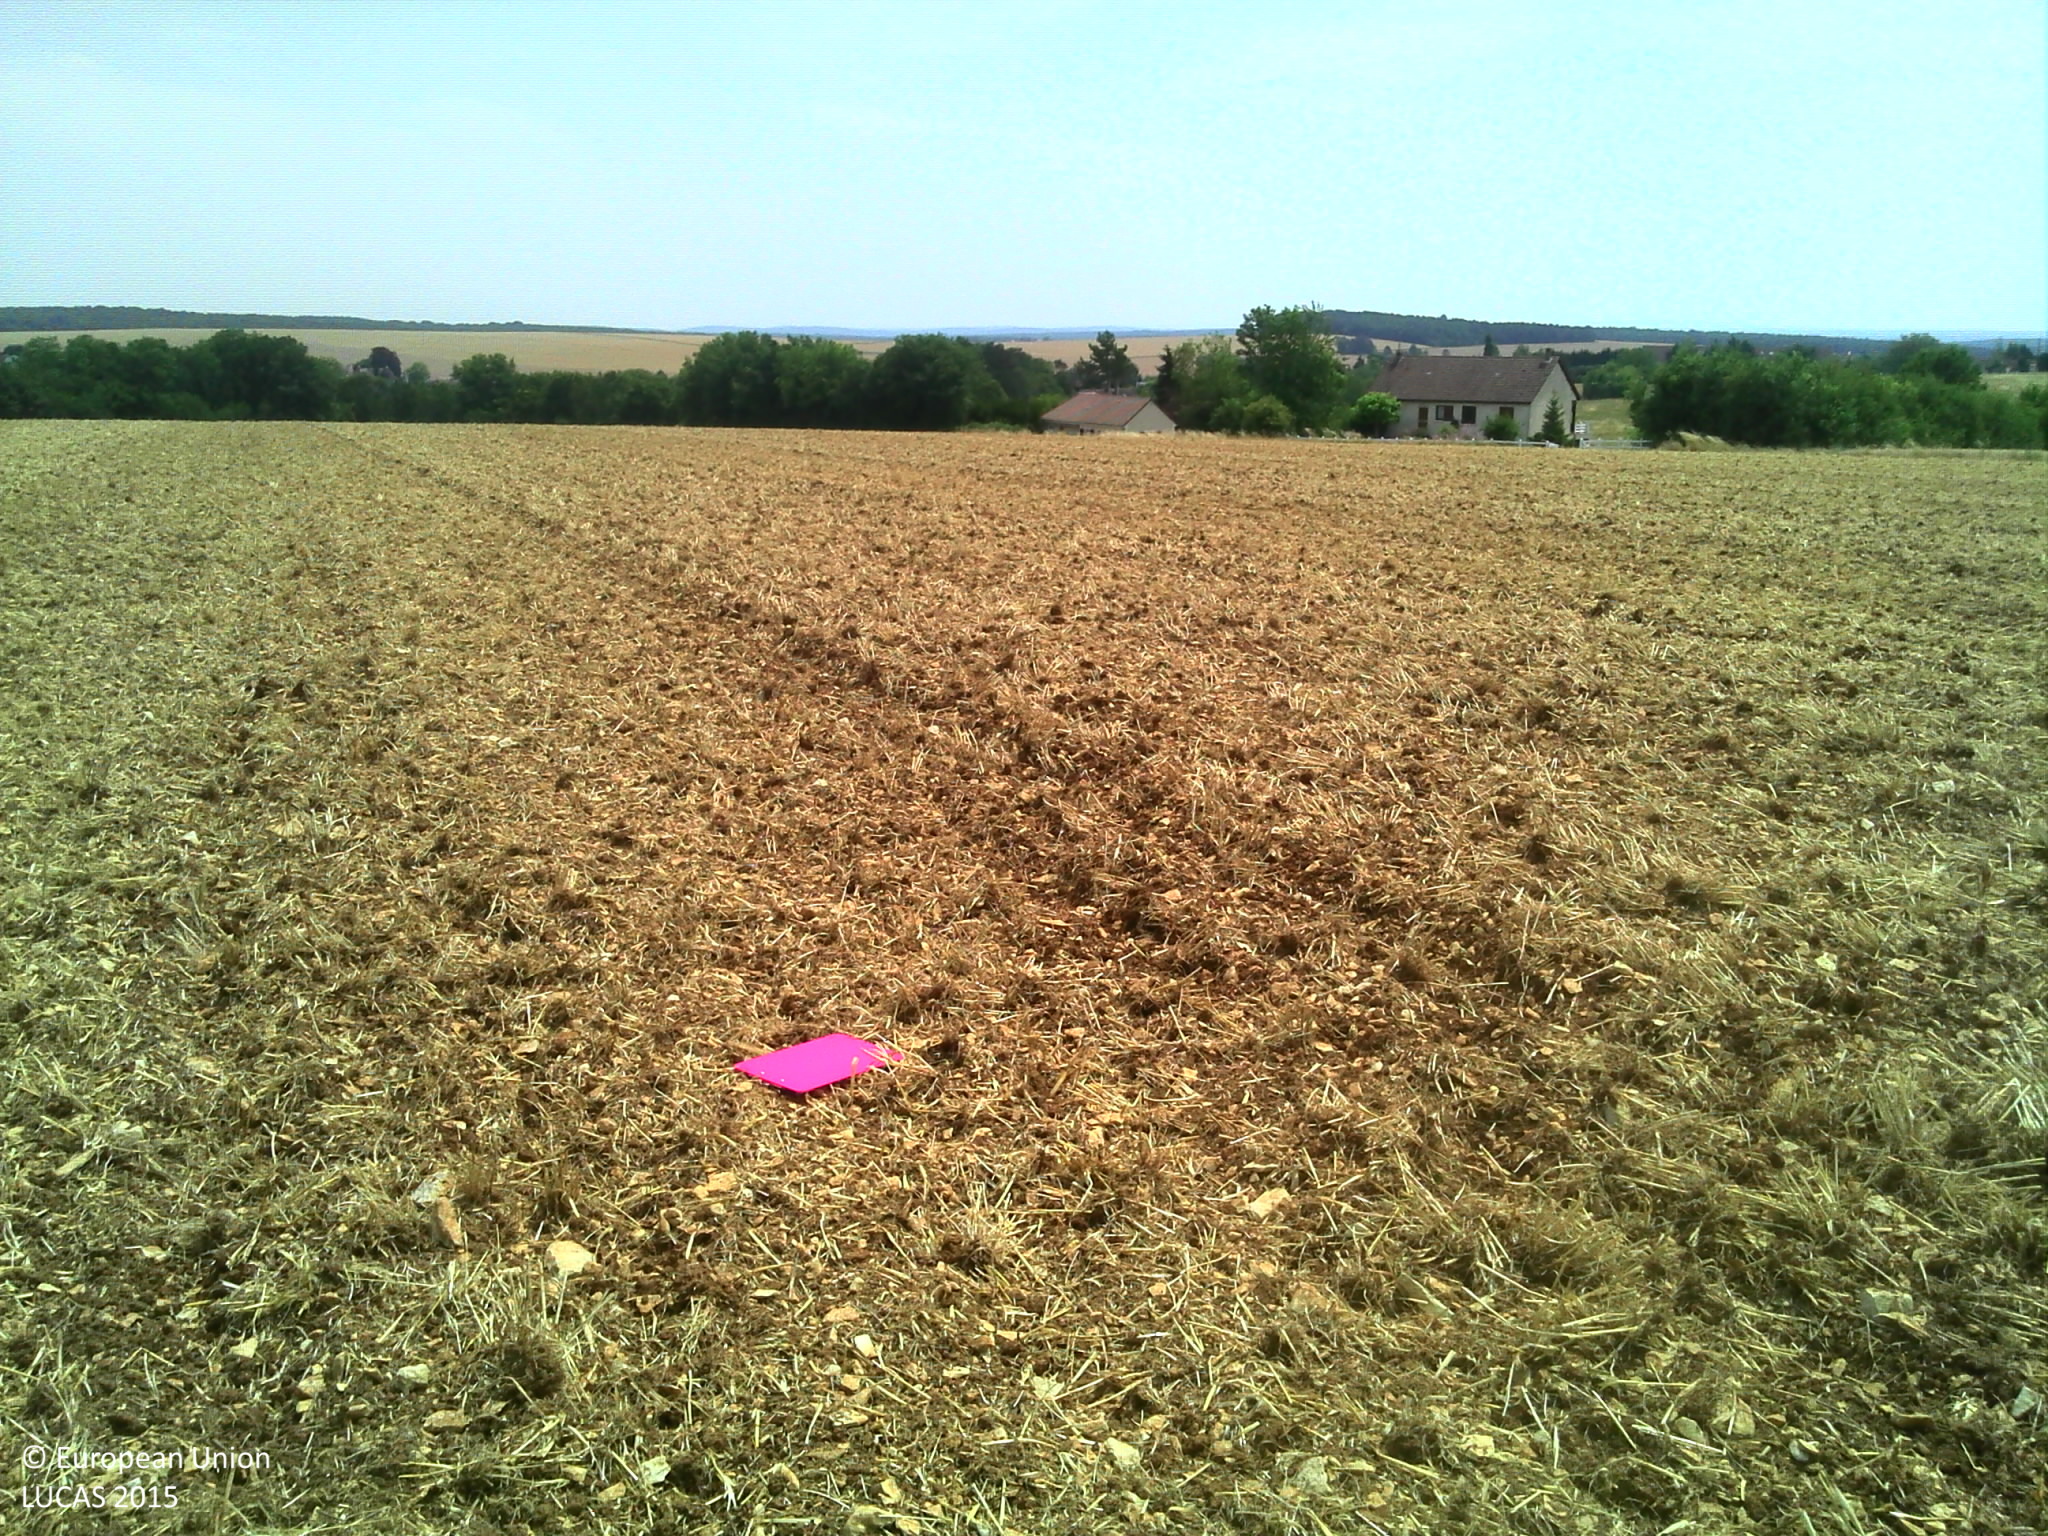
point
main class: Cropland
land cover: Barley
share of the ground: > 75 %
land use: Agriculture (excluding fallow land and kitchen gardens)
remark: Harvested field
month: July
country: FR
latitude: 47.6158
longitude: 3.4900
